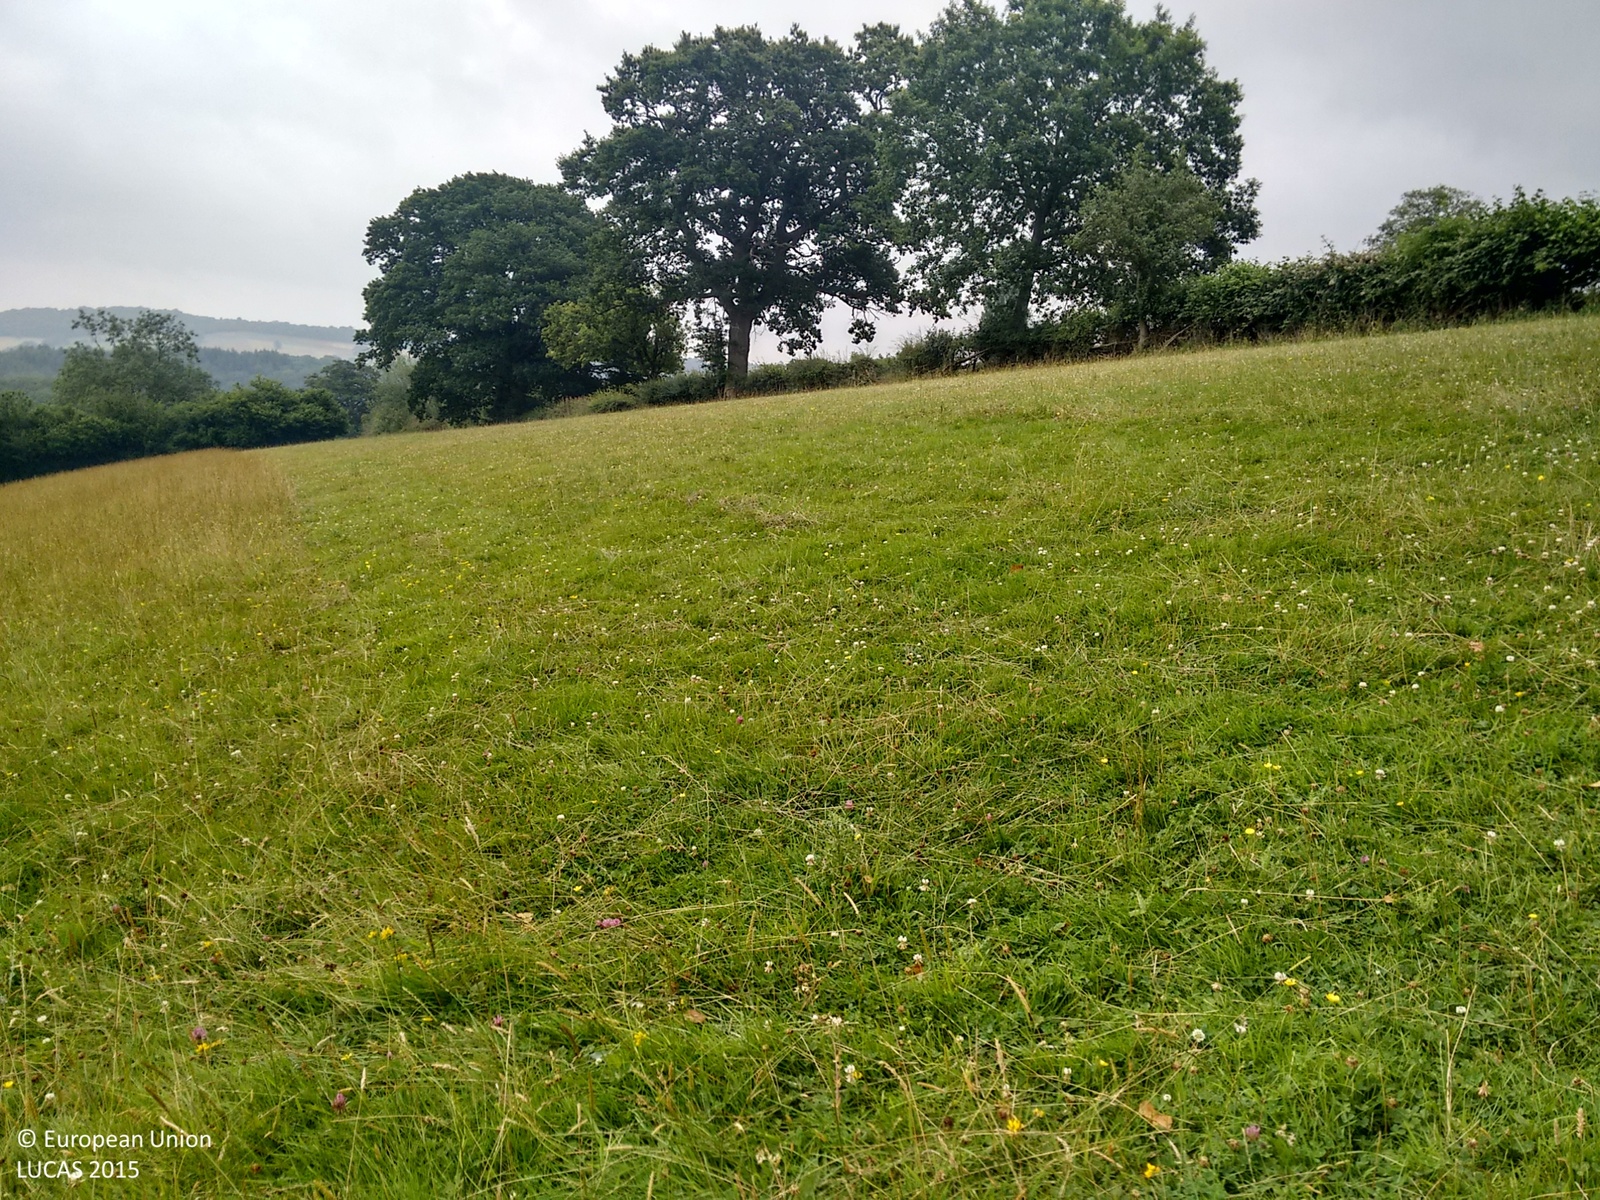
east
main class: Grassland
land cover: Grassland without tree/shrub cover
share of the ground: > 75 %
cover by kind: herbaceous plants 100 %
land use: Agriculture (excluding fallow land and kitchen gardens)
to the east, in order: Grassland without tree/shrub cover; Electric lines; Grassland without tree/shrub cover; Fences; Managed hedges; Single bushes/trees; Grassland without tree/shrub cover; Fences; Abandoned hedges; Single bushes/trees; Grassland without tree/shrub cover; Abandoned hedges; Fences; Single bushes/trees; Fences; Grassland without tree/shrub cover
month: July
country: GB
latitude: 51.9963
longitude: -2.5788
